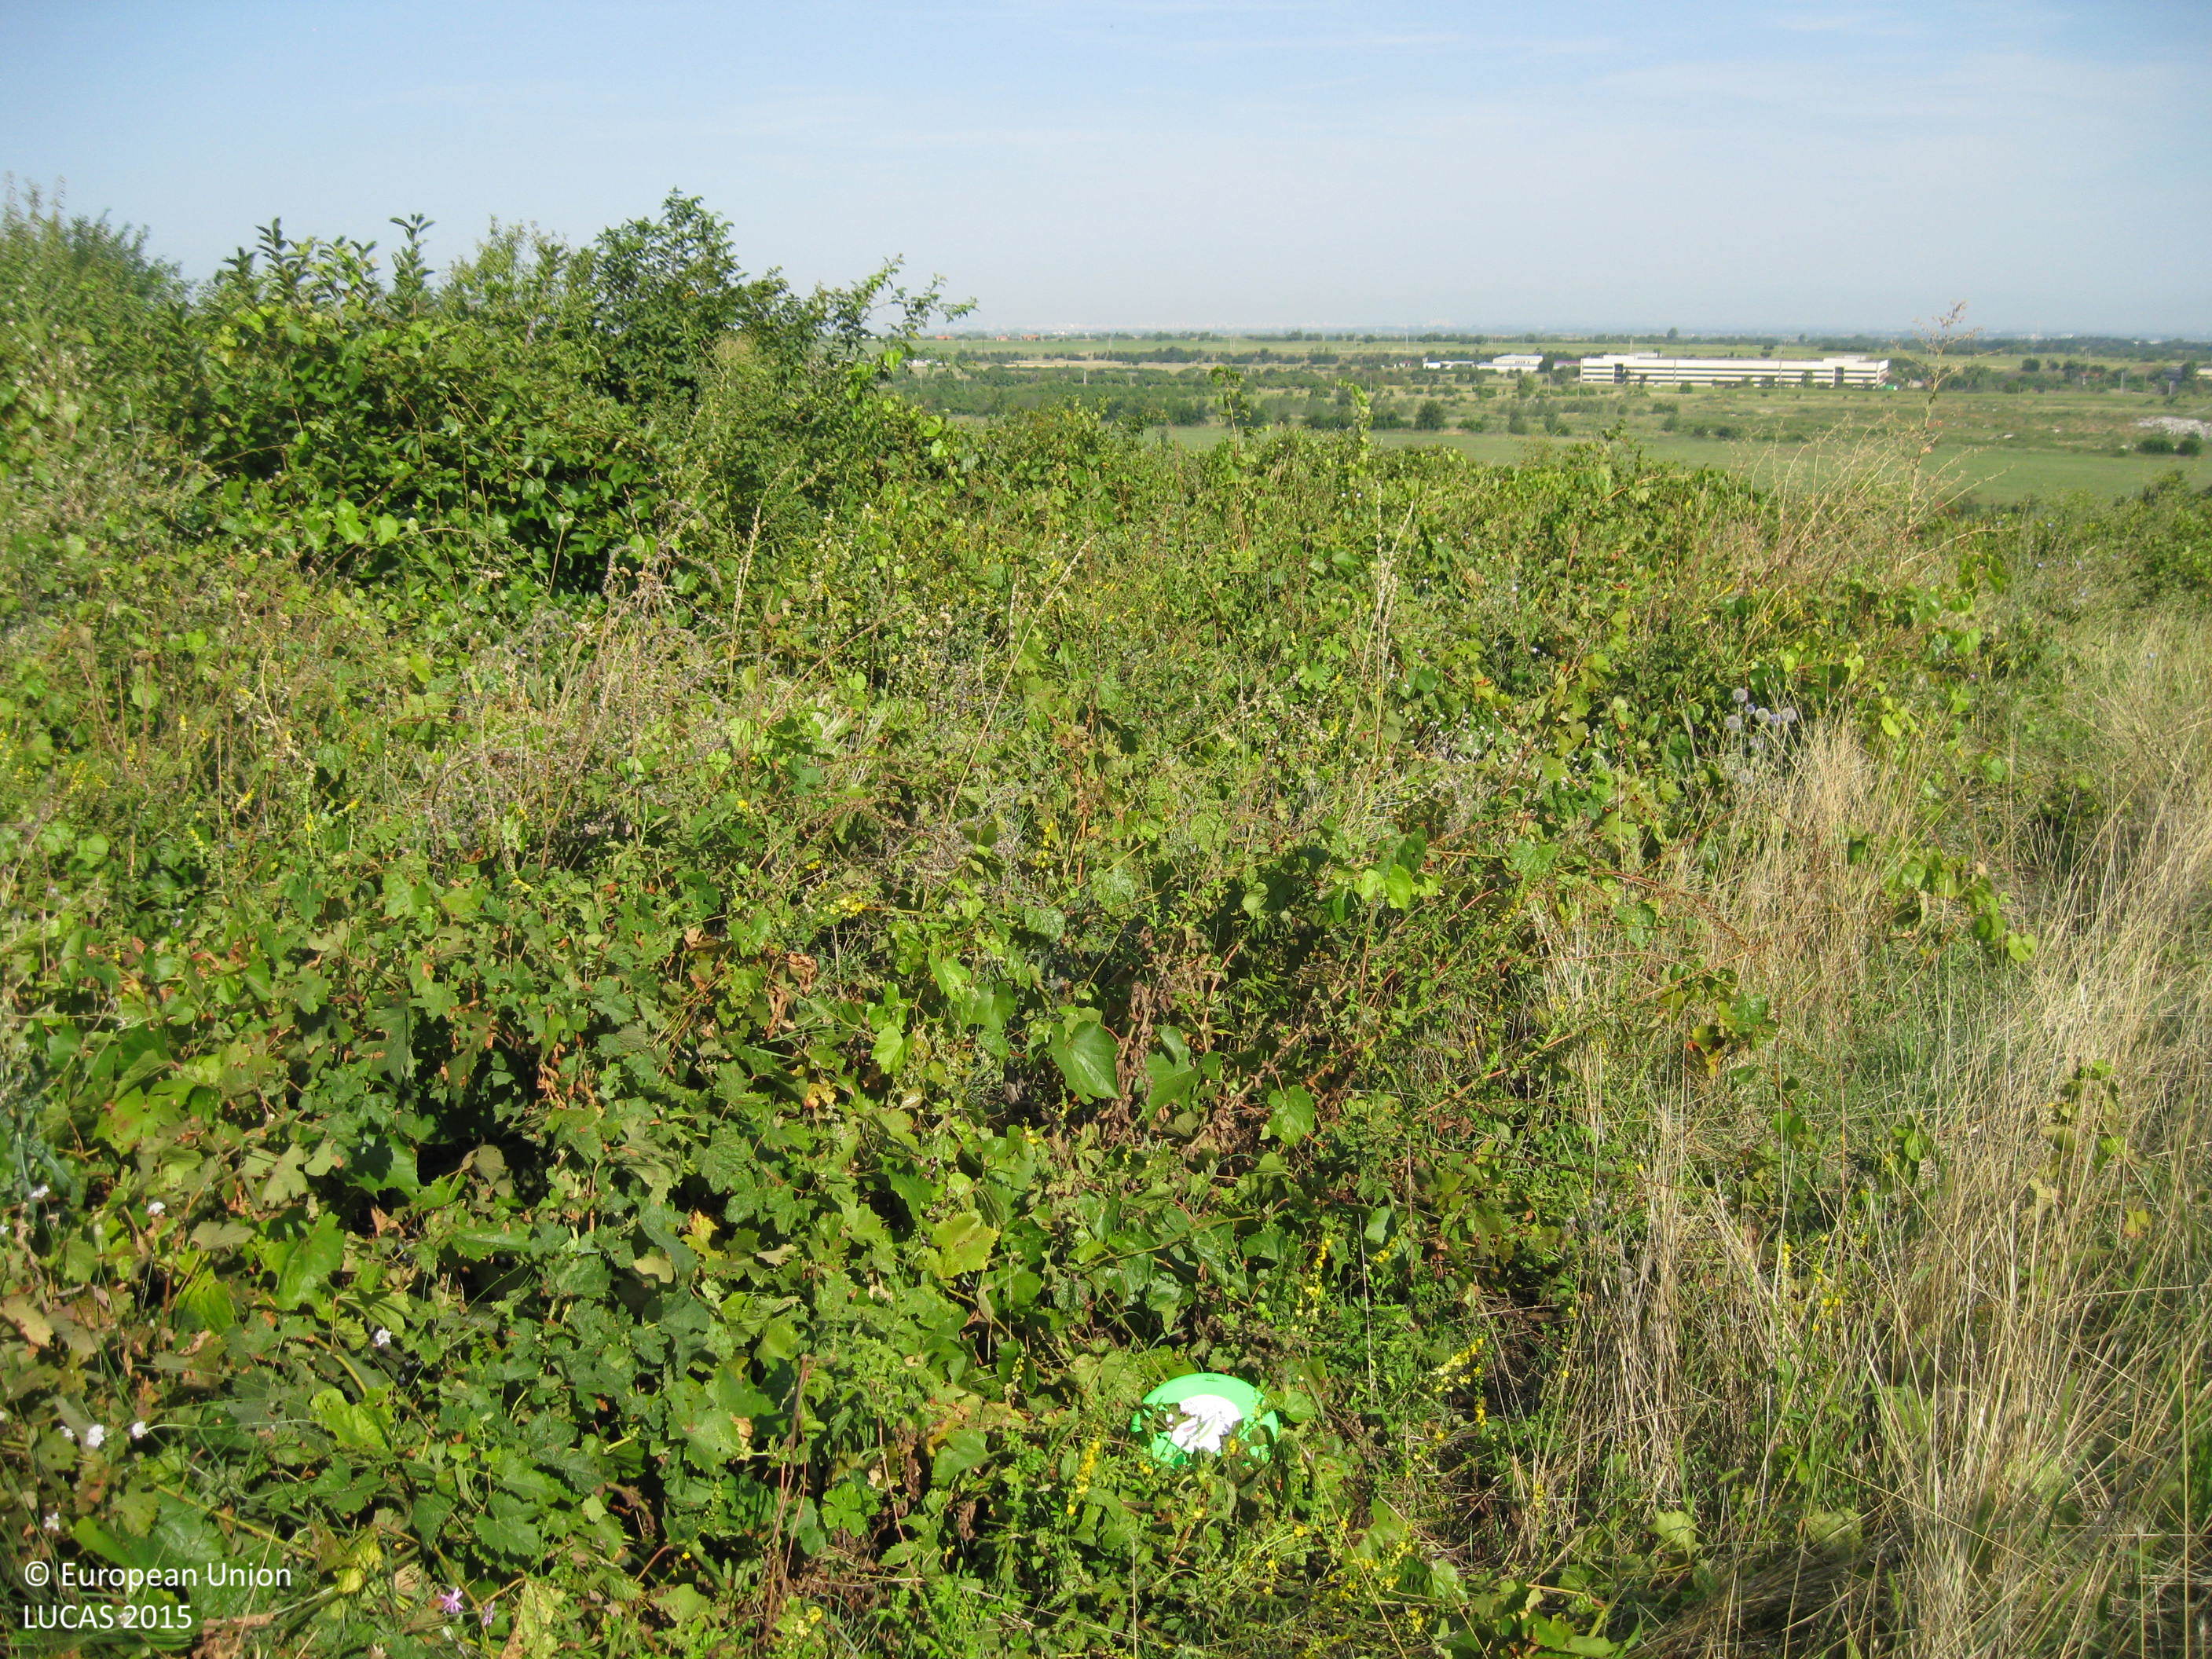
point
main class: Cropland
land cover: Vineyards
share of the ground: > 75 %
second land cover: Spontaneously vegetated surfaces
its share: > 75 %
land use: Agriculture (excluding fallow land and kitchen gardens)
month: August
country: BG
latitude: 42.0187
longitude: 24.9190
